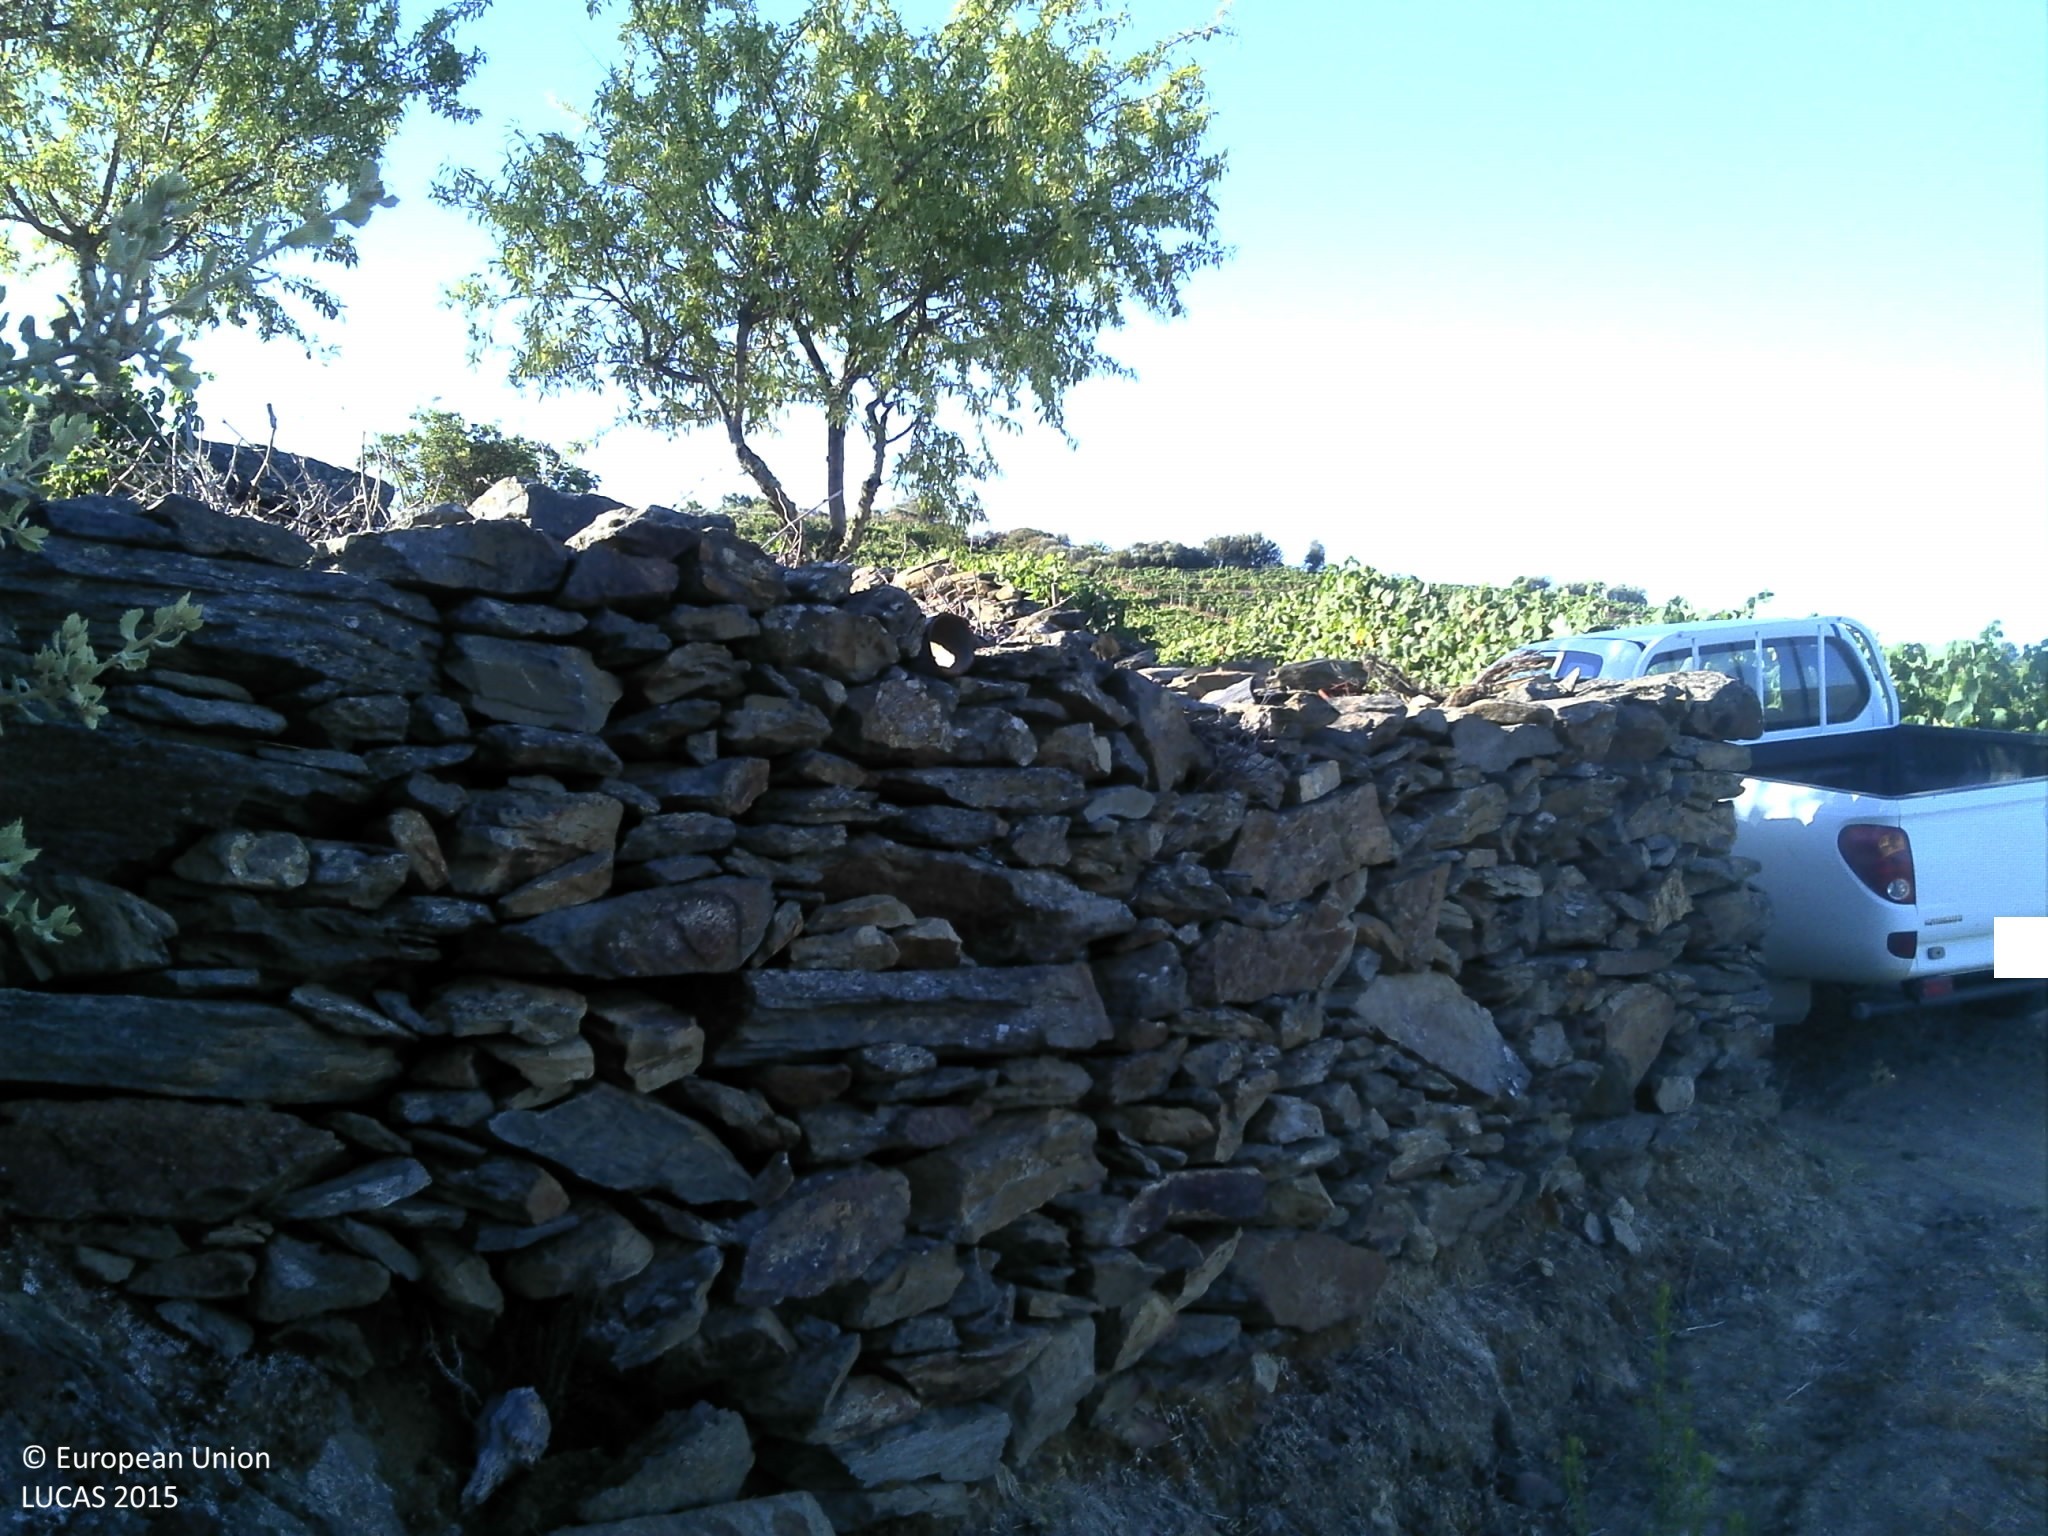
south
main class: Cropland
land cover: Vineyards
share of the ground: < 10 %
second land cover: Other bare soil
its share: > 75 %
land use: Agriculture (excluding fallow land and kitchen gardens)
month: July
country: PT
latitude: 41.2254
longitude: -7.4059
